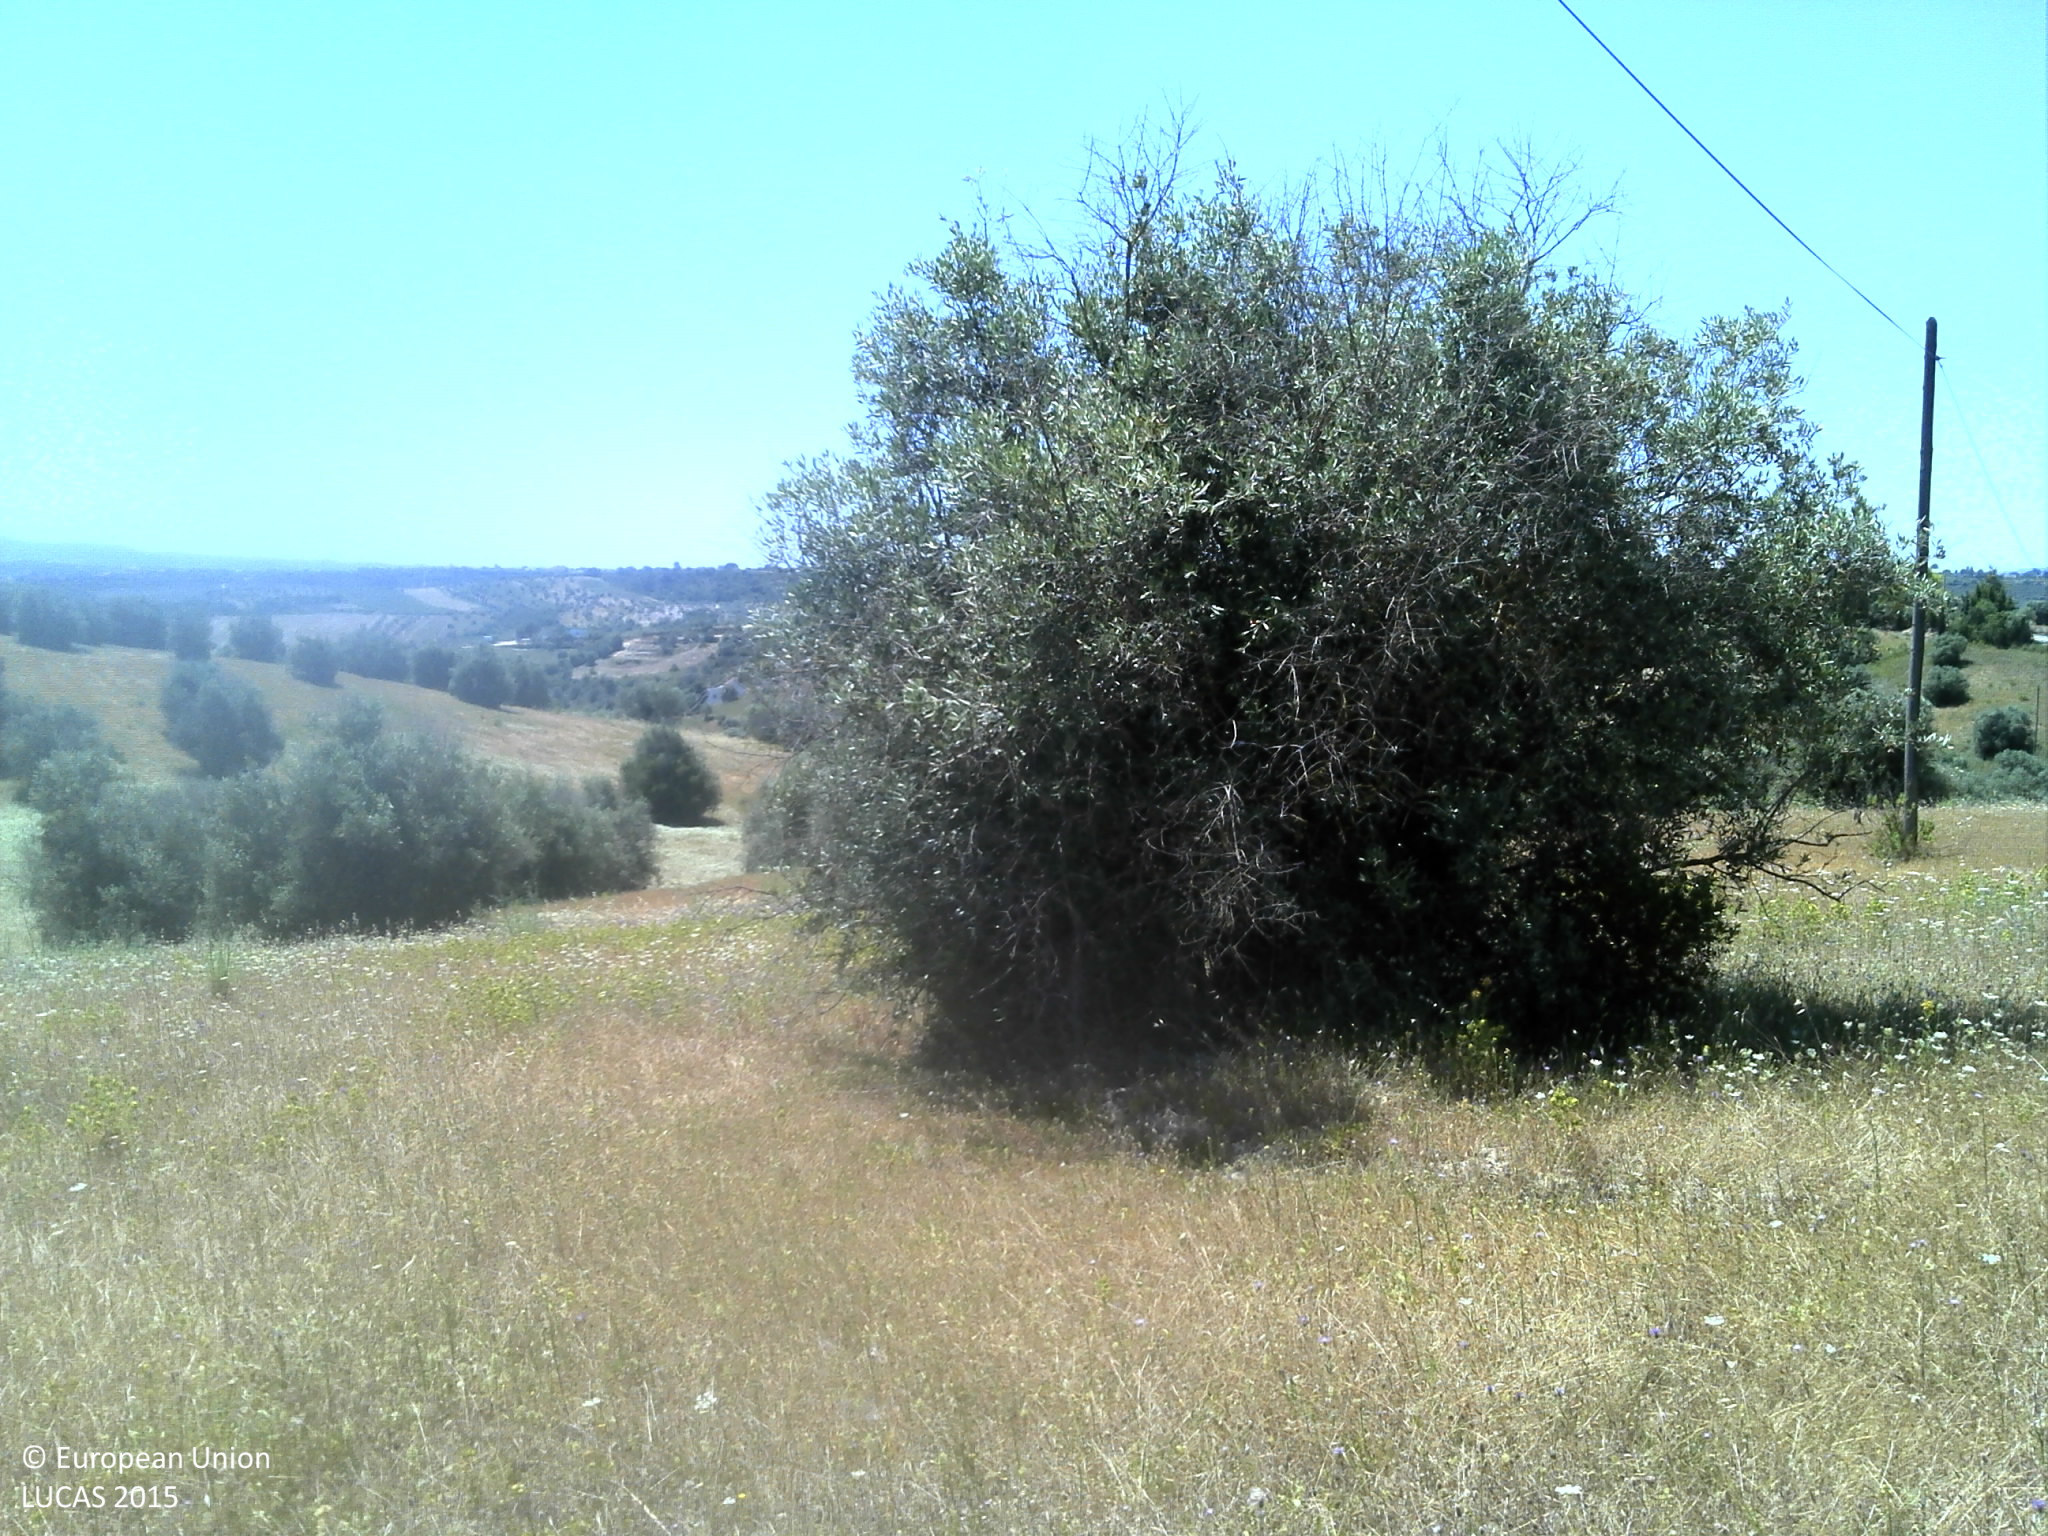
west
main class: Cropland
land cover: Olive groves
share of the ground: 10 - 25 %
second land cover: Grassland without tree/shrub cover
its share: 50 - 75 %
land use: Agriculture (excluding fallow land and kitchen gardens)
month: May
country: PT
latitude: 39.2876
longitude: -8.7769
